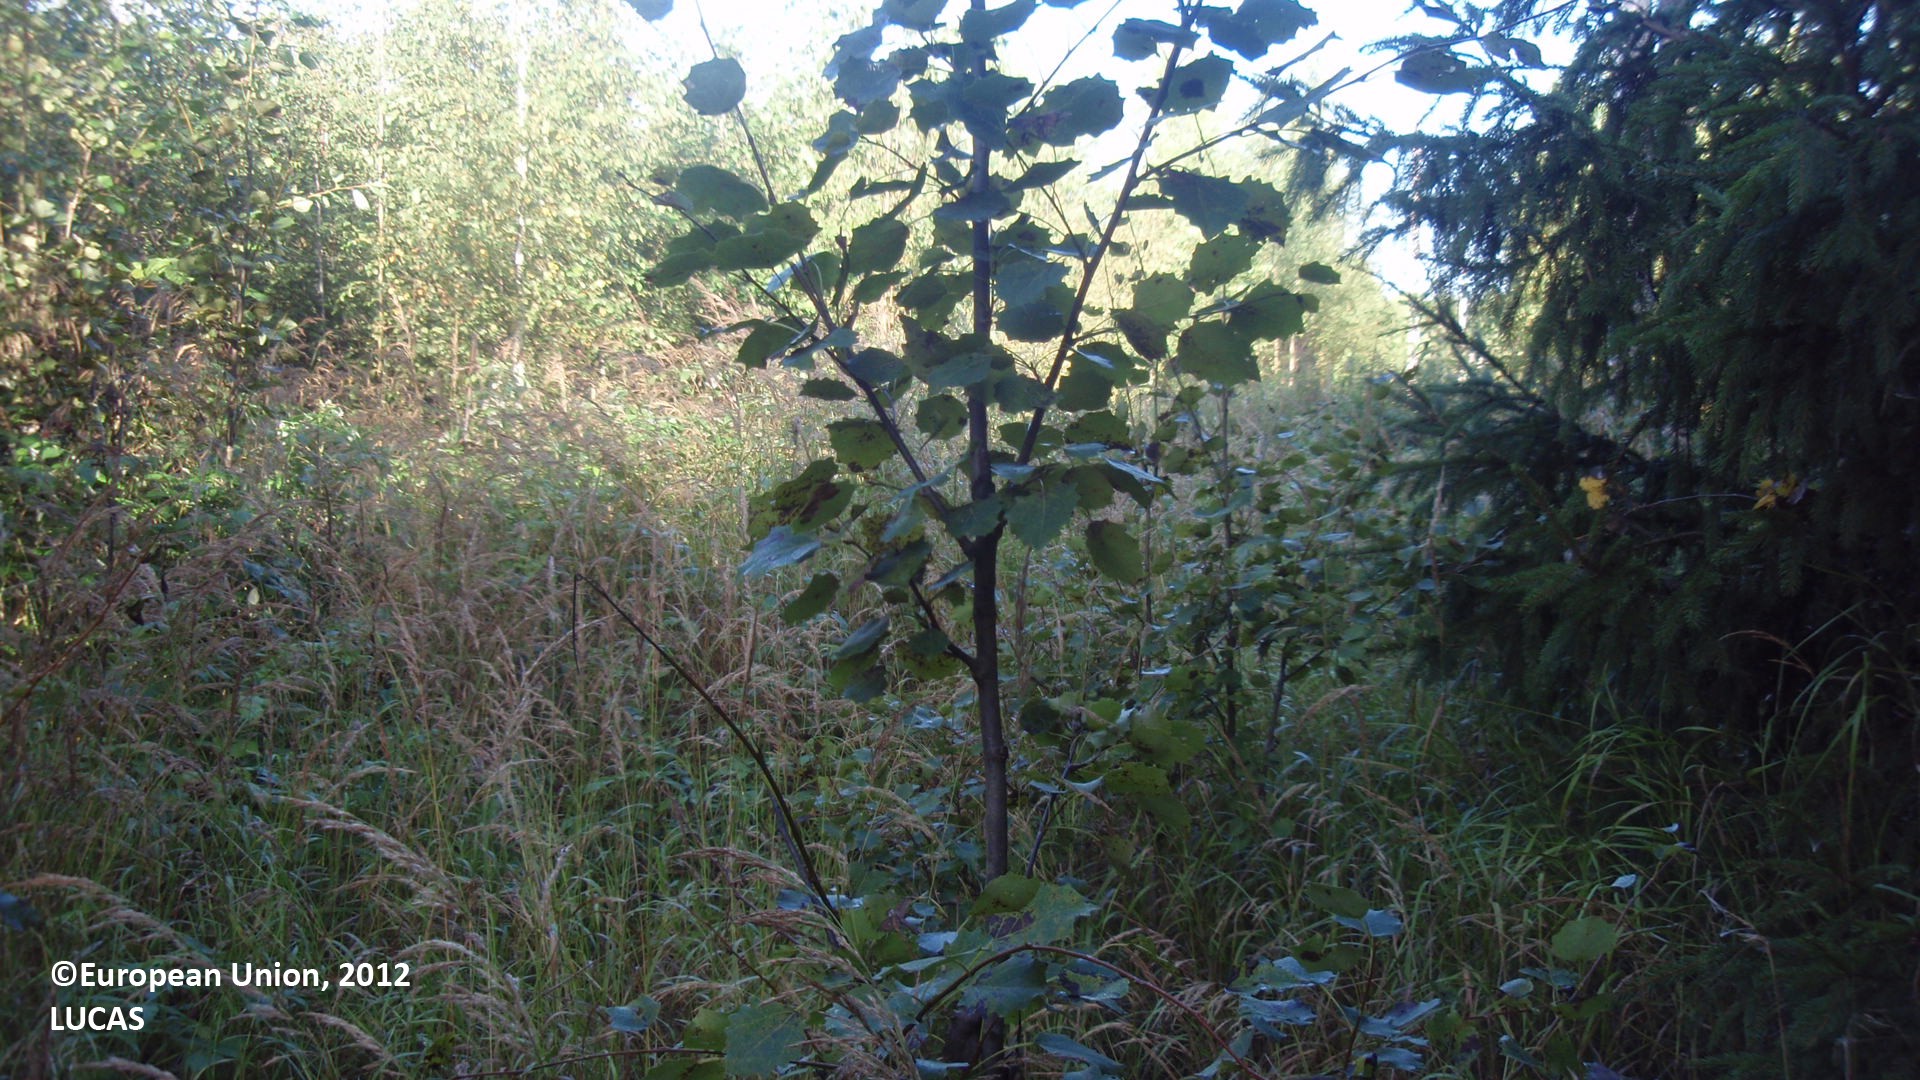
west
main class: Woodland
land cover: Broadleaved woodland
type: boreal forest
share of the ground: 50 - 75 %
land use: Forestry
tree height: > 5 m
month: August
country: FI
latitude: 60.6205
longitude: 27.2636
